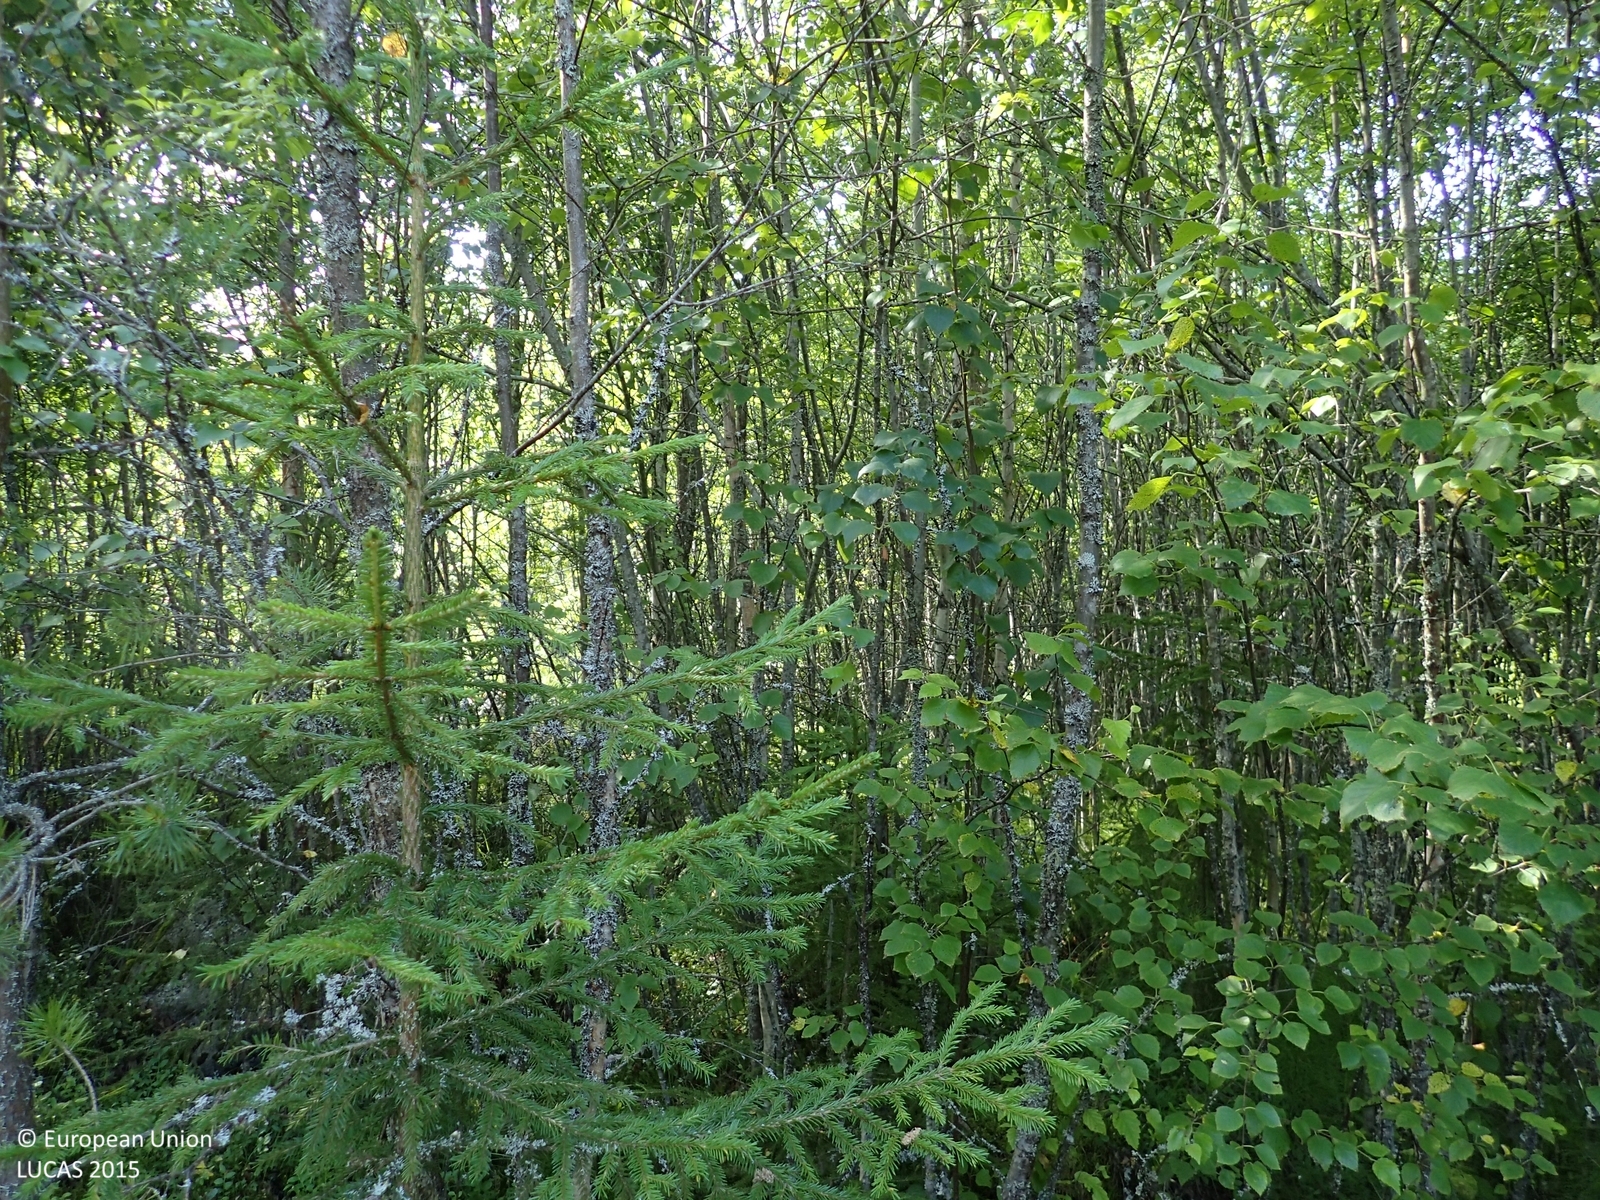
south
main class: Woodland
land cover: Broadleaved woodland
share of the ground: > 75 %
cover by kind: broadleaved forest trees 65 %, coniferous forest trees 10 %, shrubs 10 %, herbaceous plants 10 %, lichens and mosses 5 %
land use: Forestry
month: August
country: FI
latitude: 62.9438
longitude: 21.8875
